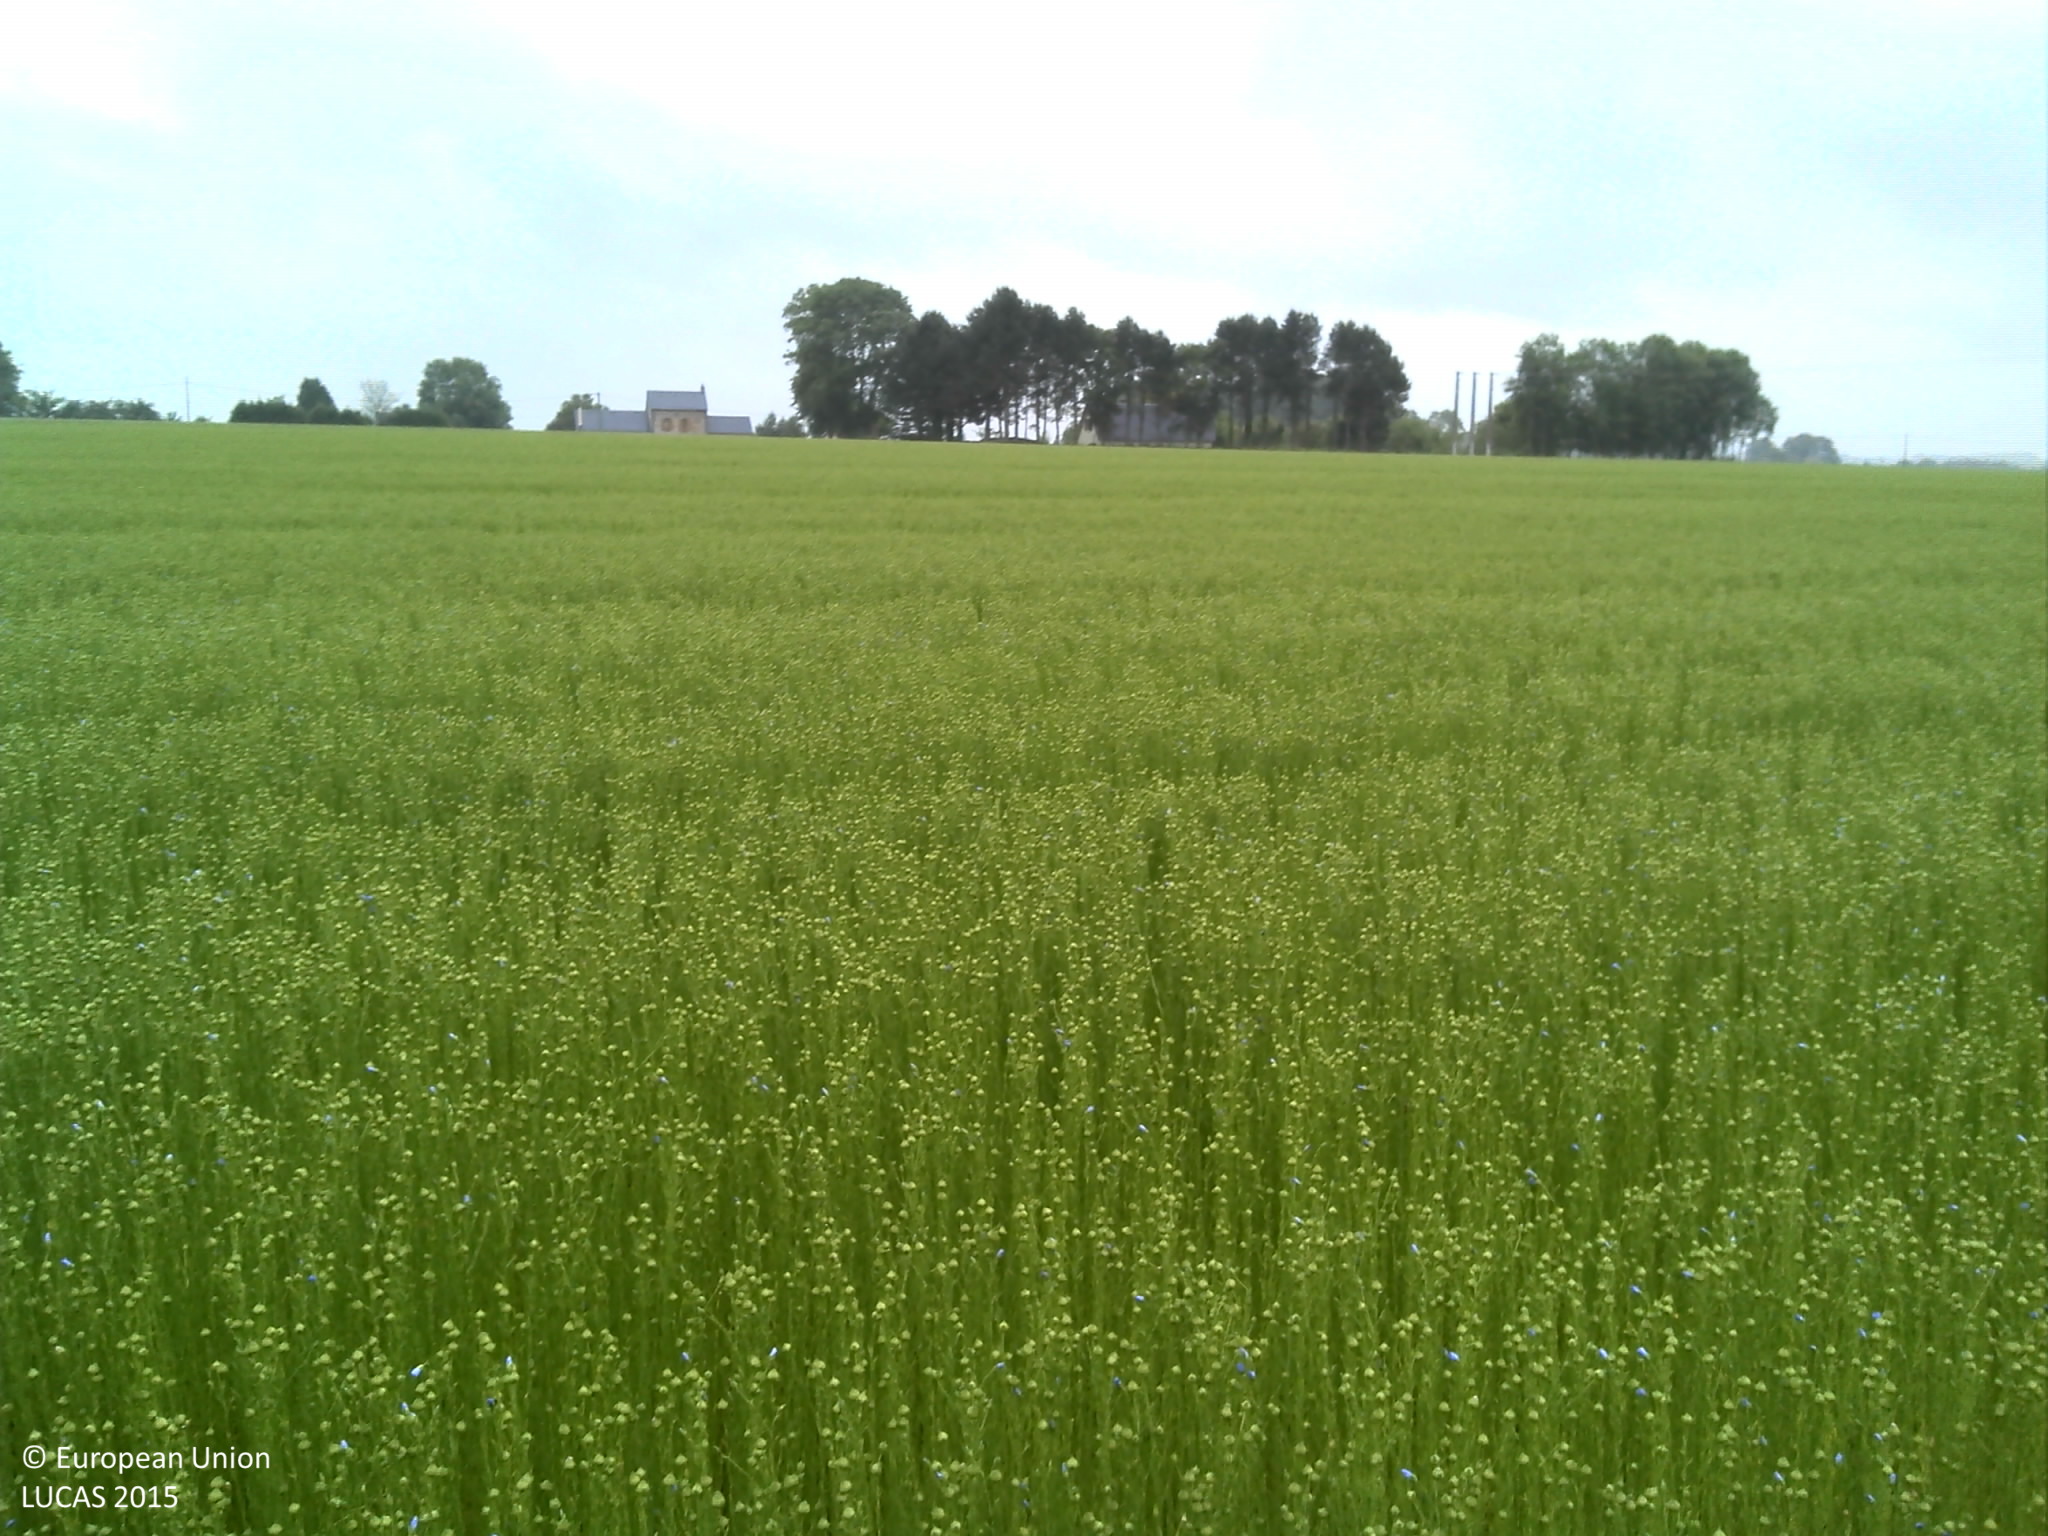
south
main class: Cropland
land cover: Rape and turnip rape
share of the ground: > 75 %
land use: Agriculture (excluding fallow land and kitchen gardens)
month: June
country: FR
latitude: 49.6980
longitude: 0.3079
